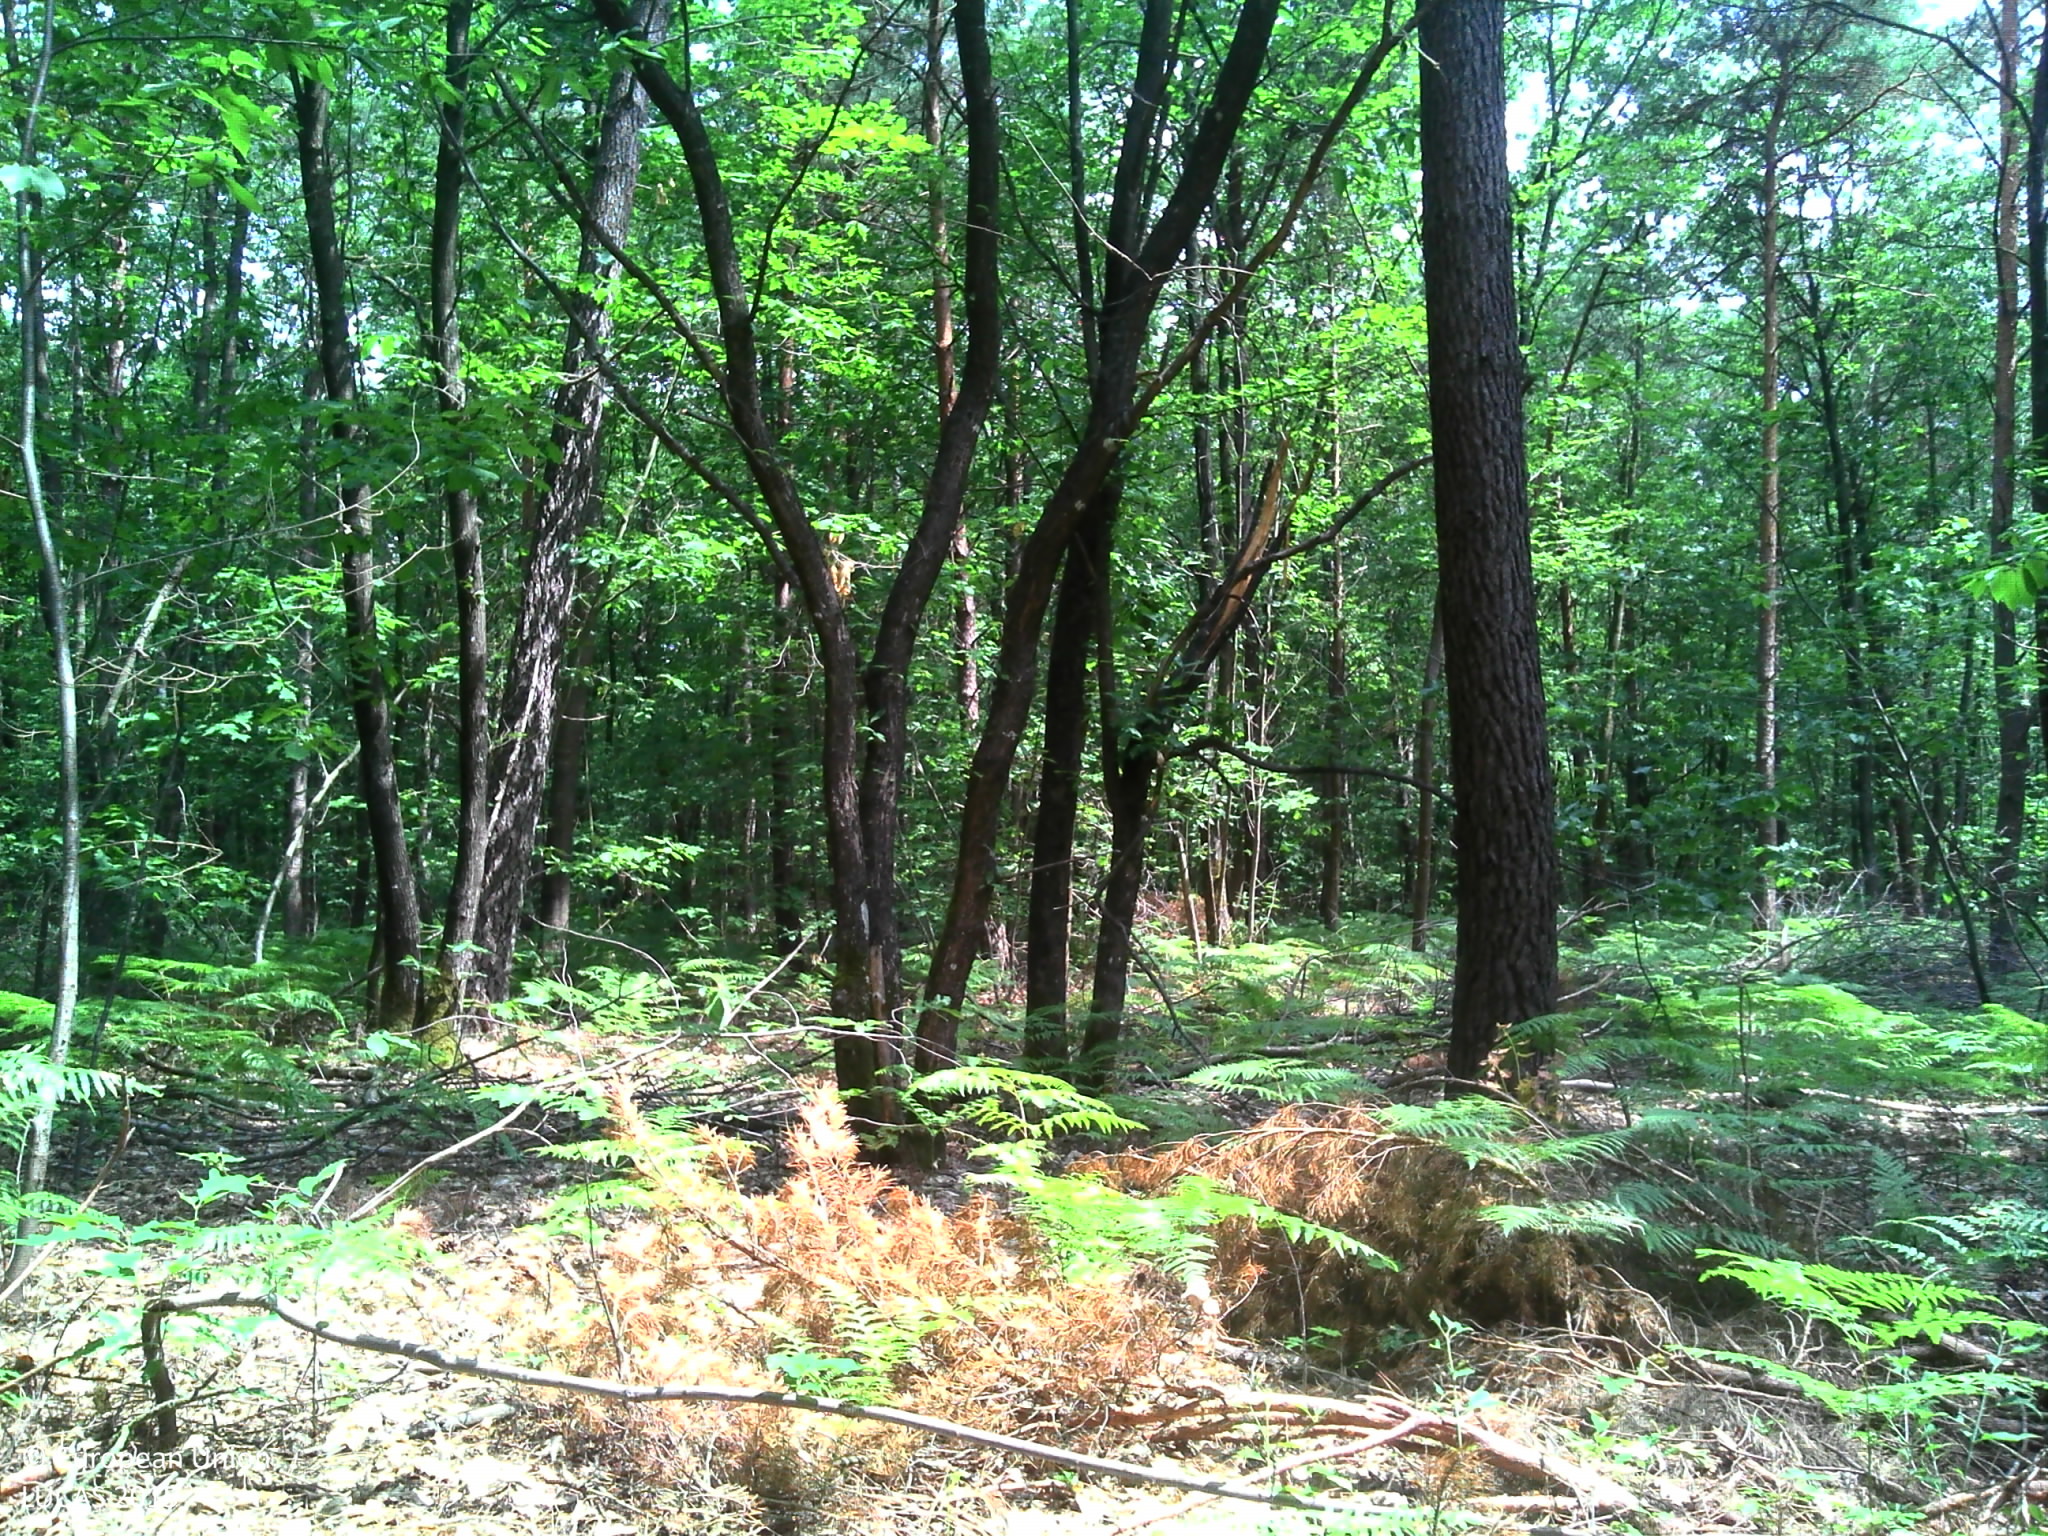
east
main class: Woodland
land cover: Pine dominated mixed woodland
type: hemiboreal forest and nemoral coniferous forest and mixed broadleaved-coniferous forest
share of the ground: > 75 %
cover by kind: broadleaved forest trees 50 %, coniferous forest trees 25 %, herbaceous plants 15 %, shrubs 10 %
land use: Forestry
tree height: > 5 m
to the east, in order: Pine dominated mixed woodland; Tracks; Pine dominated mixed woodland; Tracks; Pine dominated mixed woodland
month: July
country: FR
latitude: 47.7435
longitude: 0.3336
